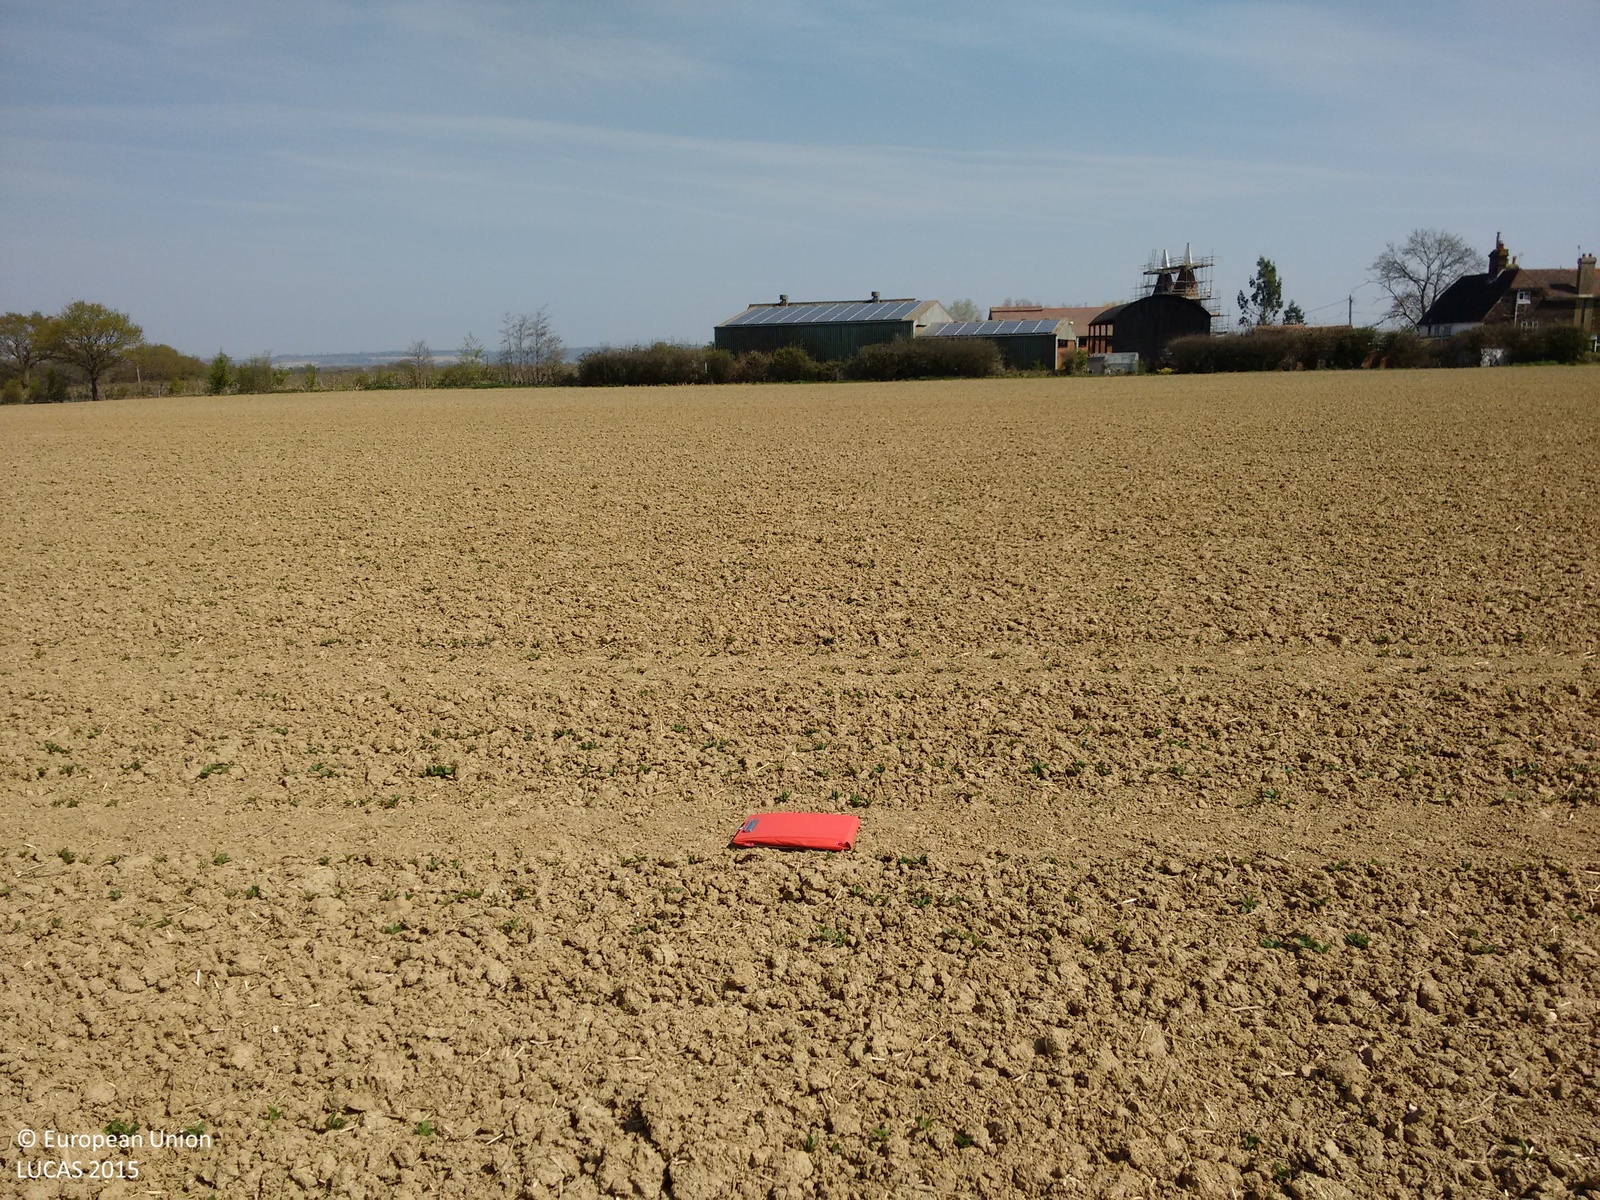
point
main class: Cropland
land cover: Dry pulses
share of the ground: < 10 %
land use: Agriculture (excluding fallow land and kitchen gardens)
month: April
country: GB
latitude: 51.1729
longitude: 0.4024
